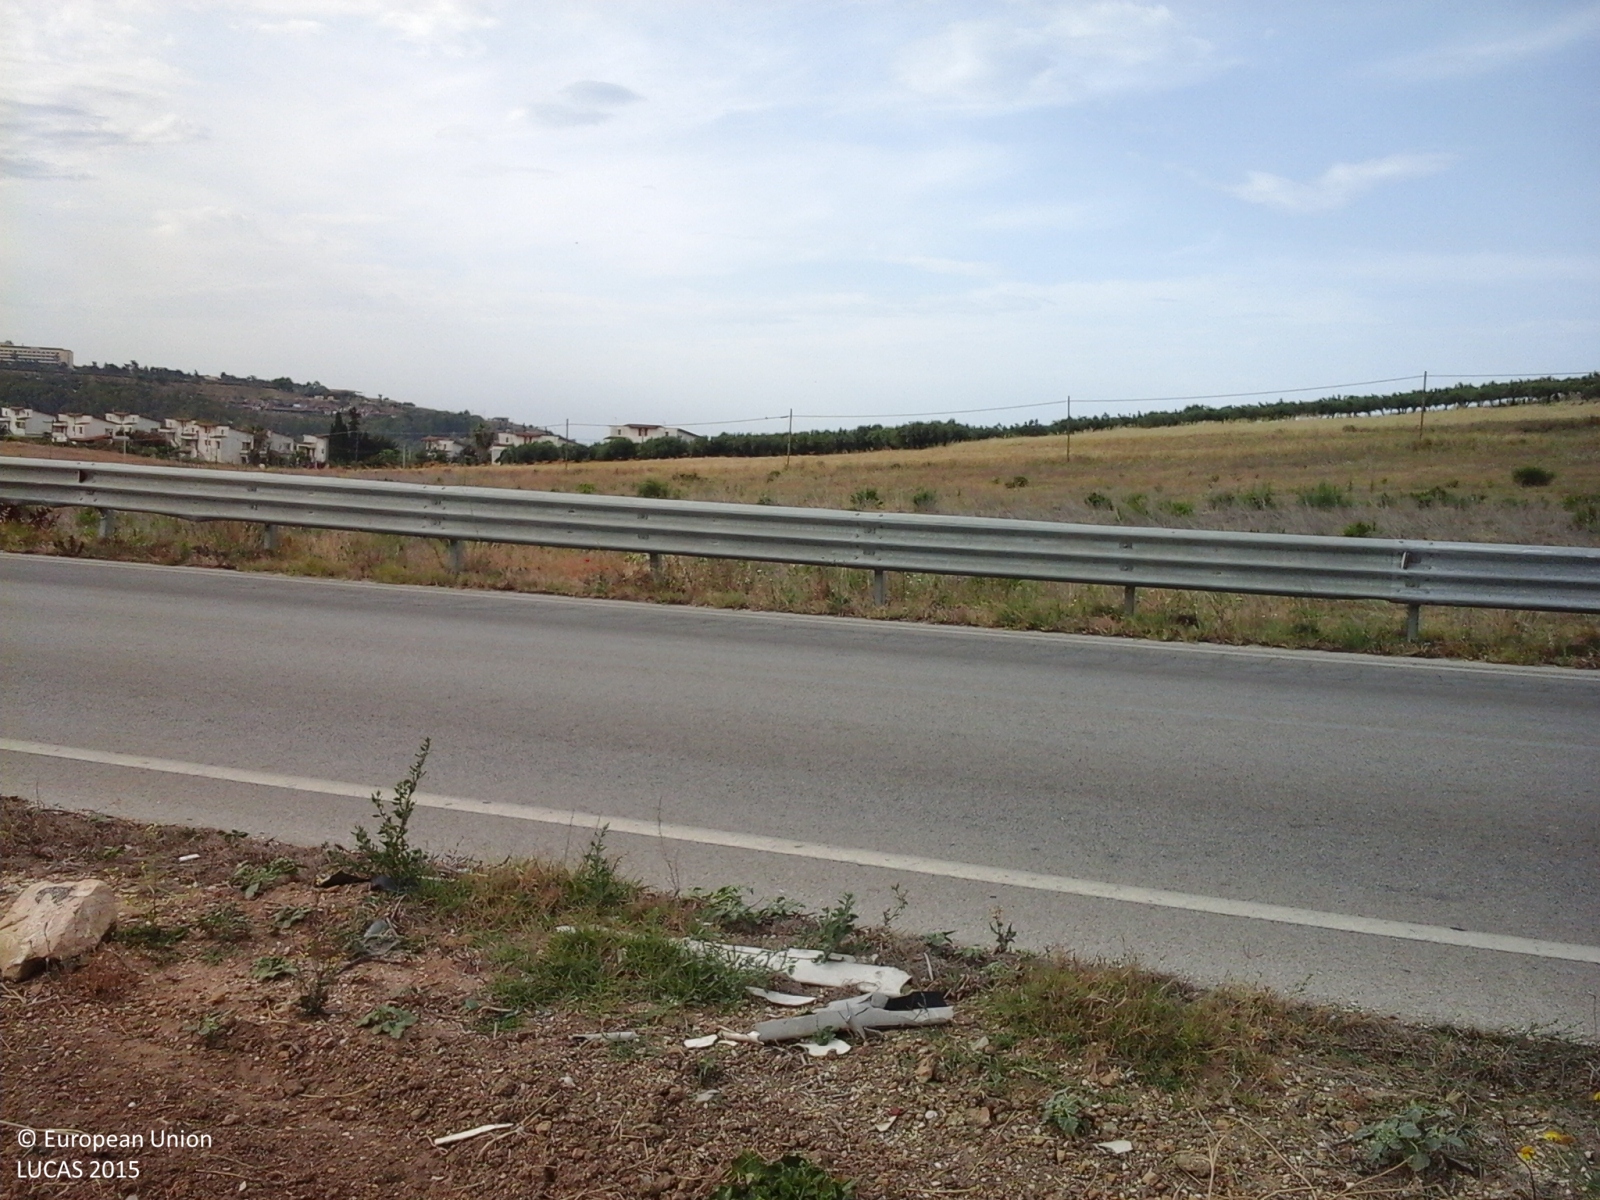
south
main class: Cropland
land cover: Olive groves
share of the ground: 25 - 50 %
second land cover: Grassland without tree/shrub cover
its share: > 75 %
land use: Agriculture (excluding fallow land and kitchen gardens)
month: June
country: IT
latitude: 37.4947
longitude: 13.1765
